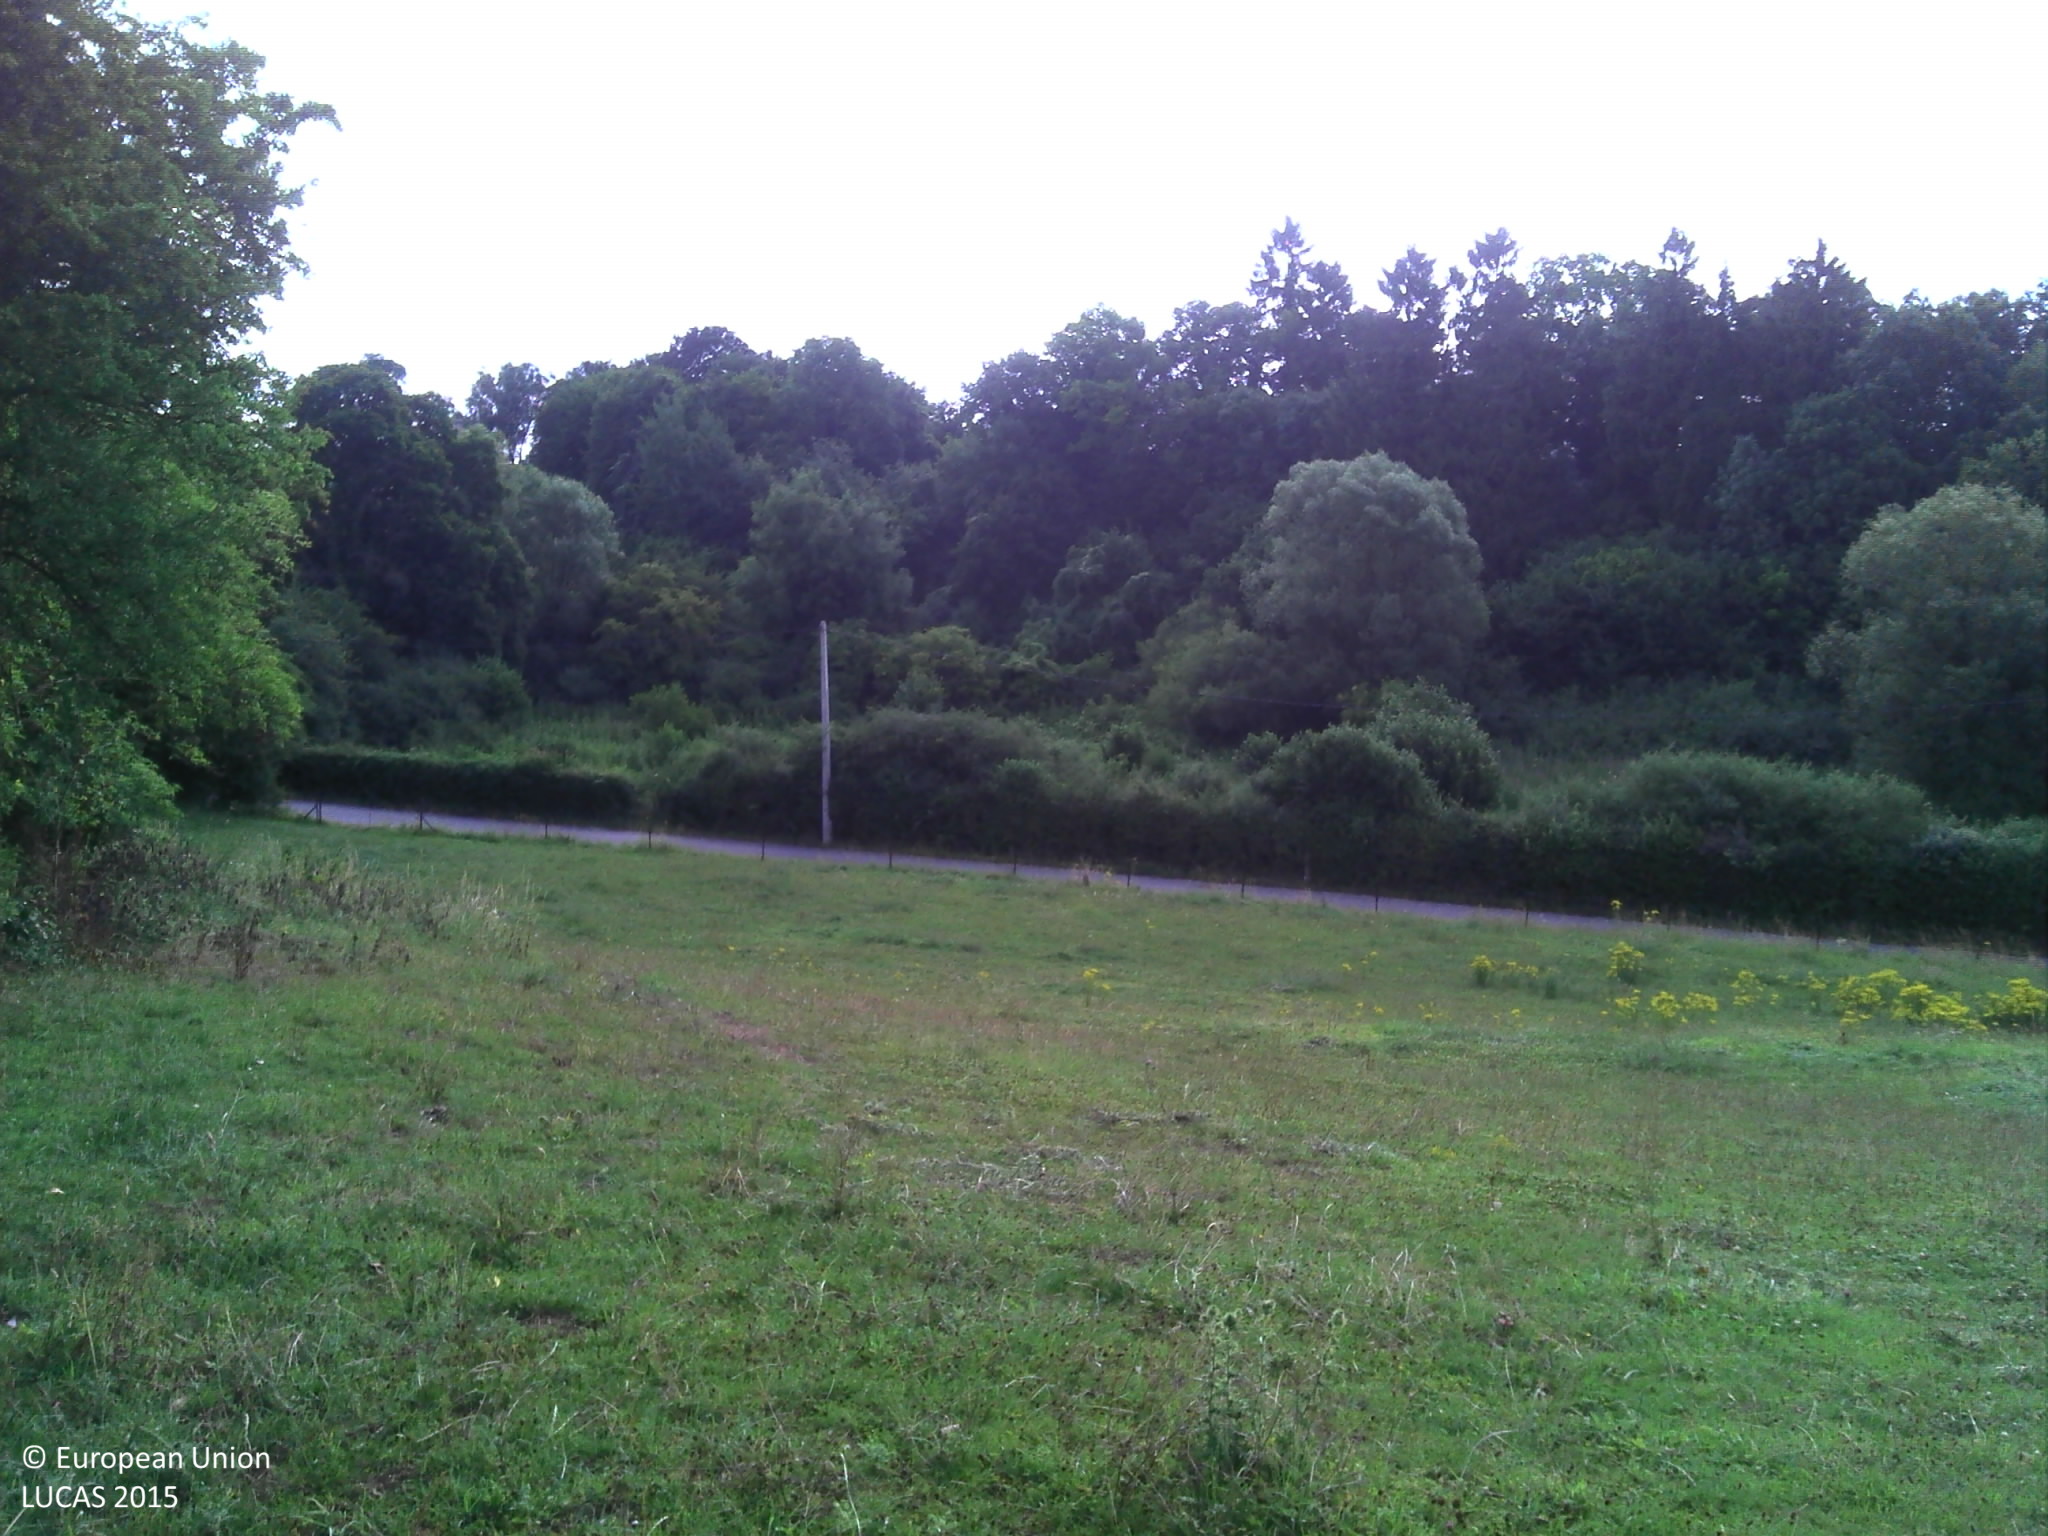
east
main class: Grassland
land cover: Grassland without tree/shrub cover
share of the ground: > 75 %
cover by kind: herbaceous plants 100 %
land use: Agriculture (excluding fallow land and kitchen gardens)
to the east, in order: Grassland without tree/shrub cover; Fences; Grass margins; Paved roads, cycling and walking lanes; Electric lines; Managed hedges; Shrubland without tree cover; Broadleaved woodland; Fences; Grassland without tree/shrub cover; Fences; Grass margins; Tracks; Grass margins; Electric lines; Grassland without tree/shrub cover
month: July
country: BE
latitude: 50.1787
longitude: 4.5207
